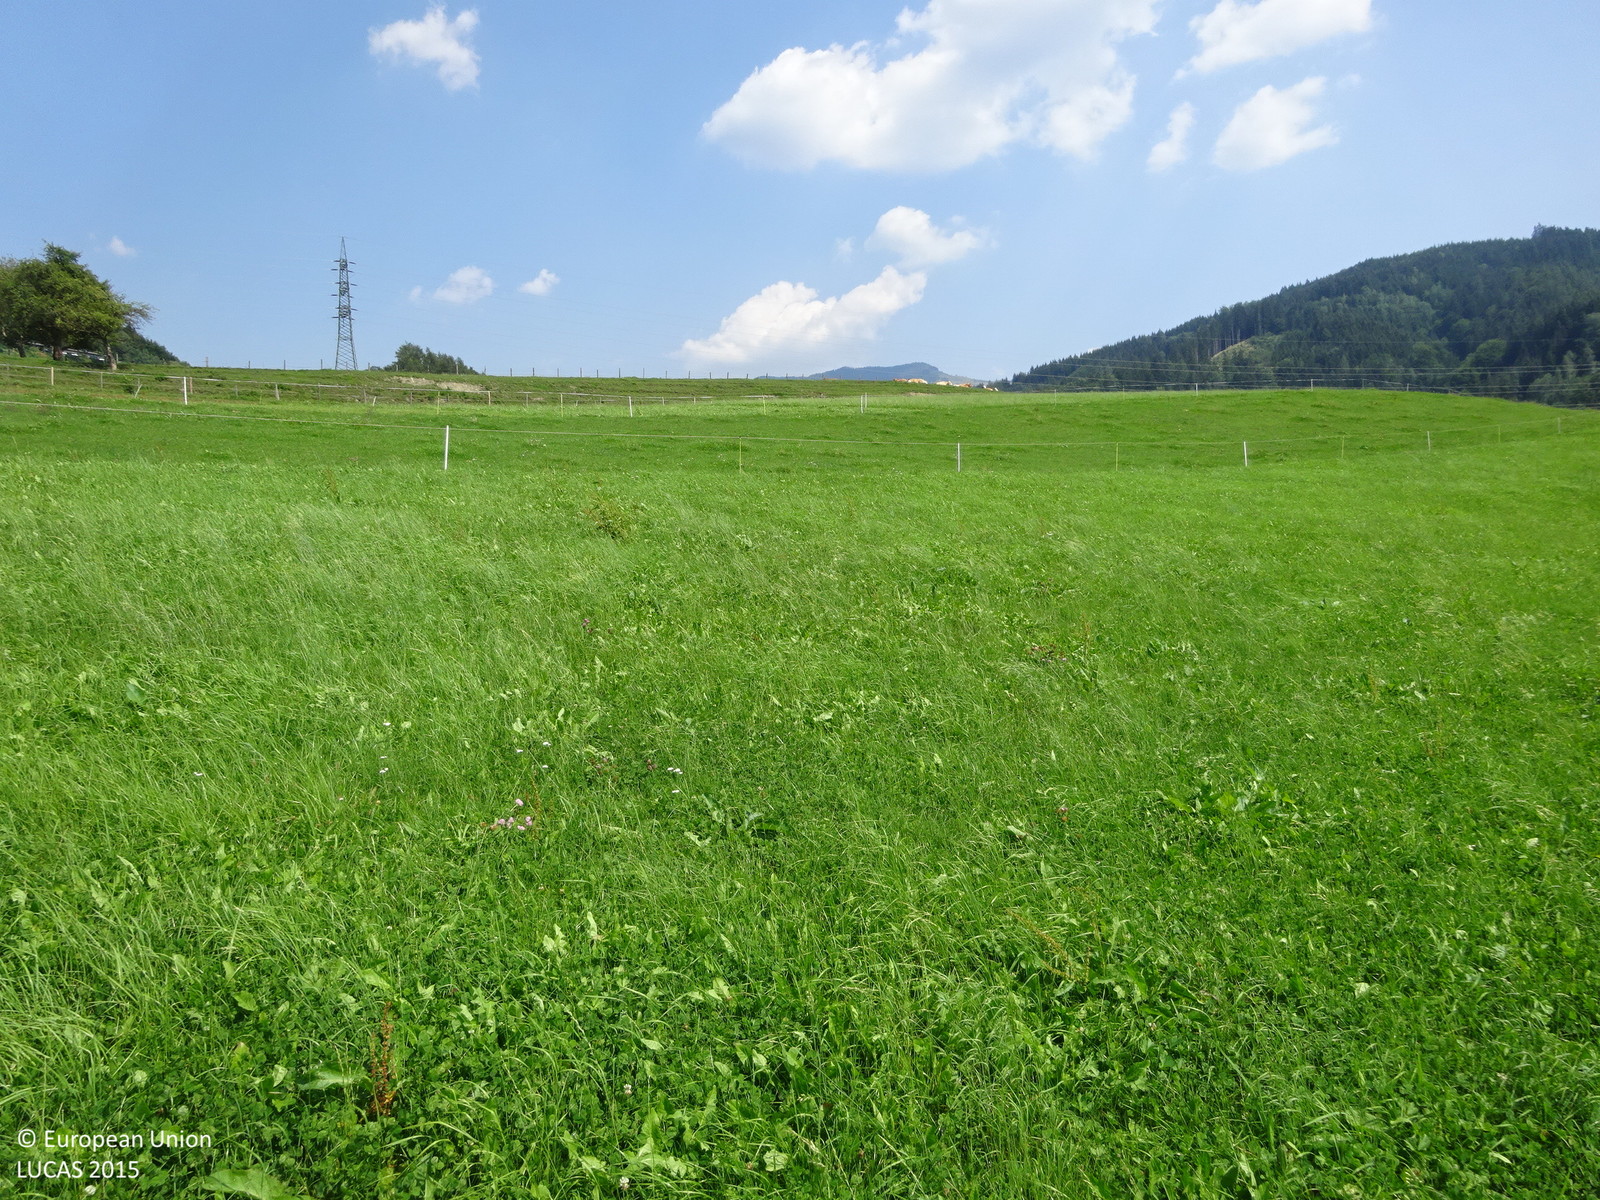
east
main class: Grassland
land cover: Grassland without tree/shrub cover
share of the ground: > 75 %
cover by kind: herbaceous plants 100 %
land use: Agriculture (excluding fallow land and kitchen gardens)
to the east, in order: Grassland without tree/shrub cover; Fences; Grassland without tree/shrub cover; Fences; Grassland without tree/shrub cover; Fences; Tracks; Fences; Grassland without tree/shrub cover; Fences; Grassland without tree/shrub cover
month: August
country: AT
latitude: 47.4113
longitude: 15.2882
